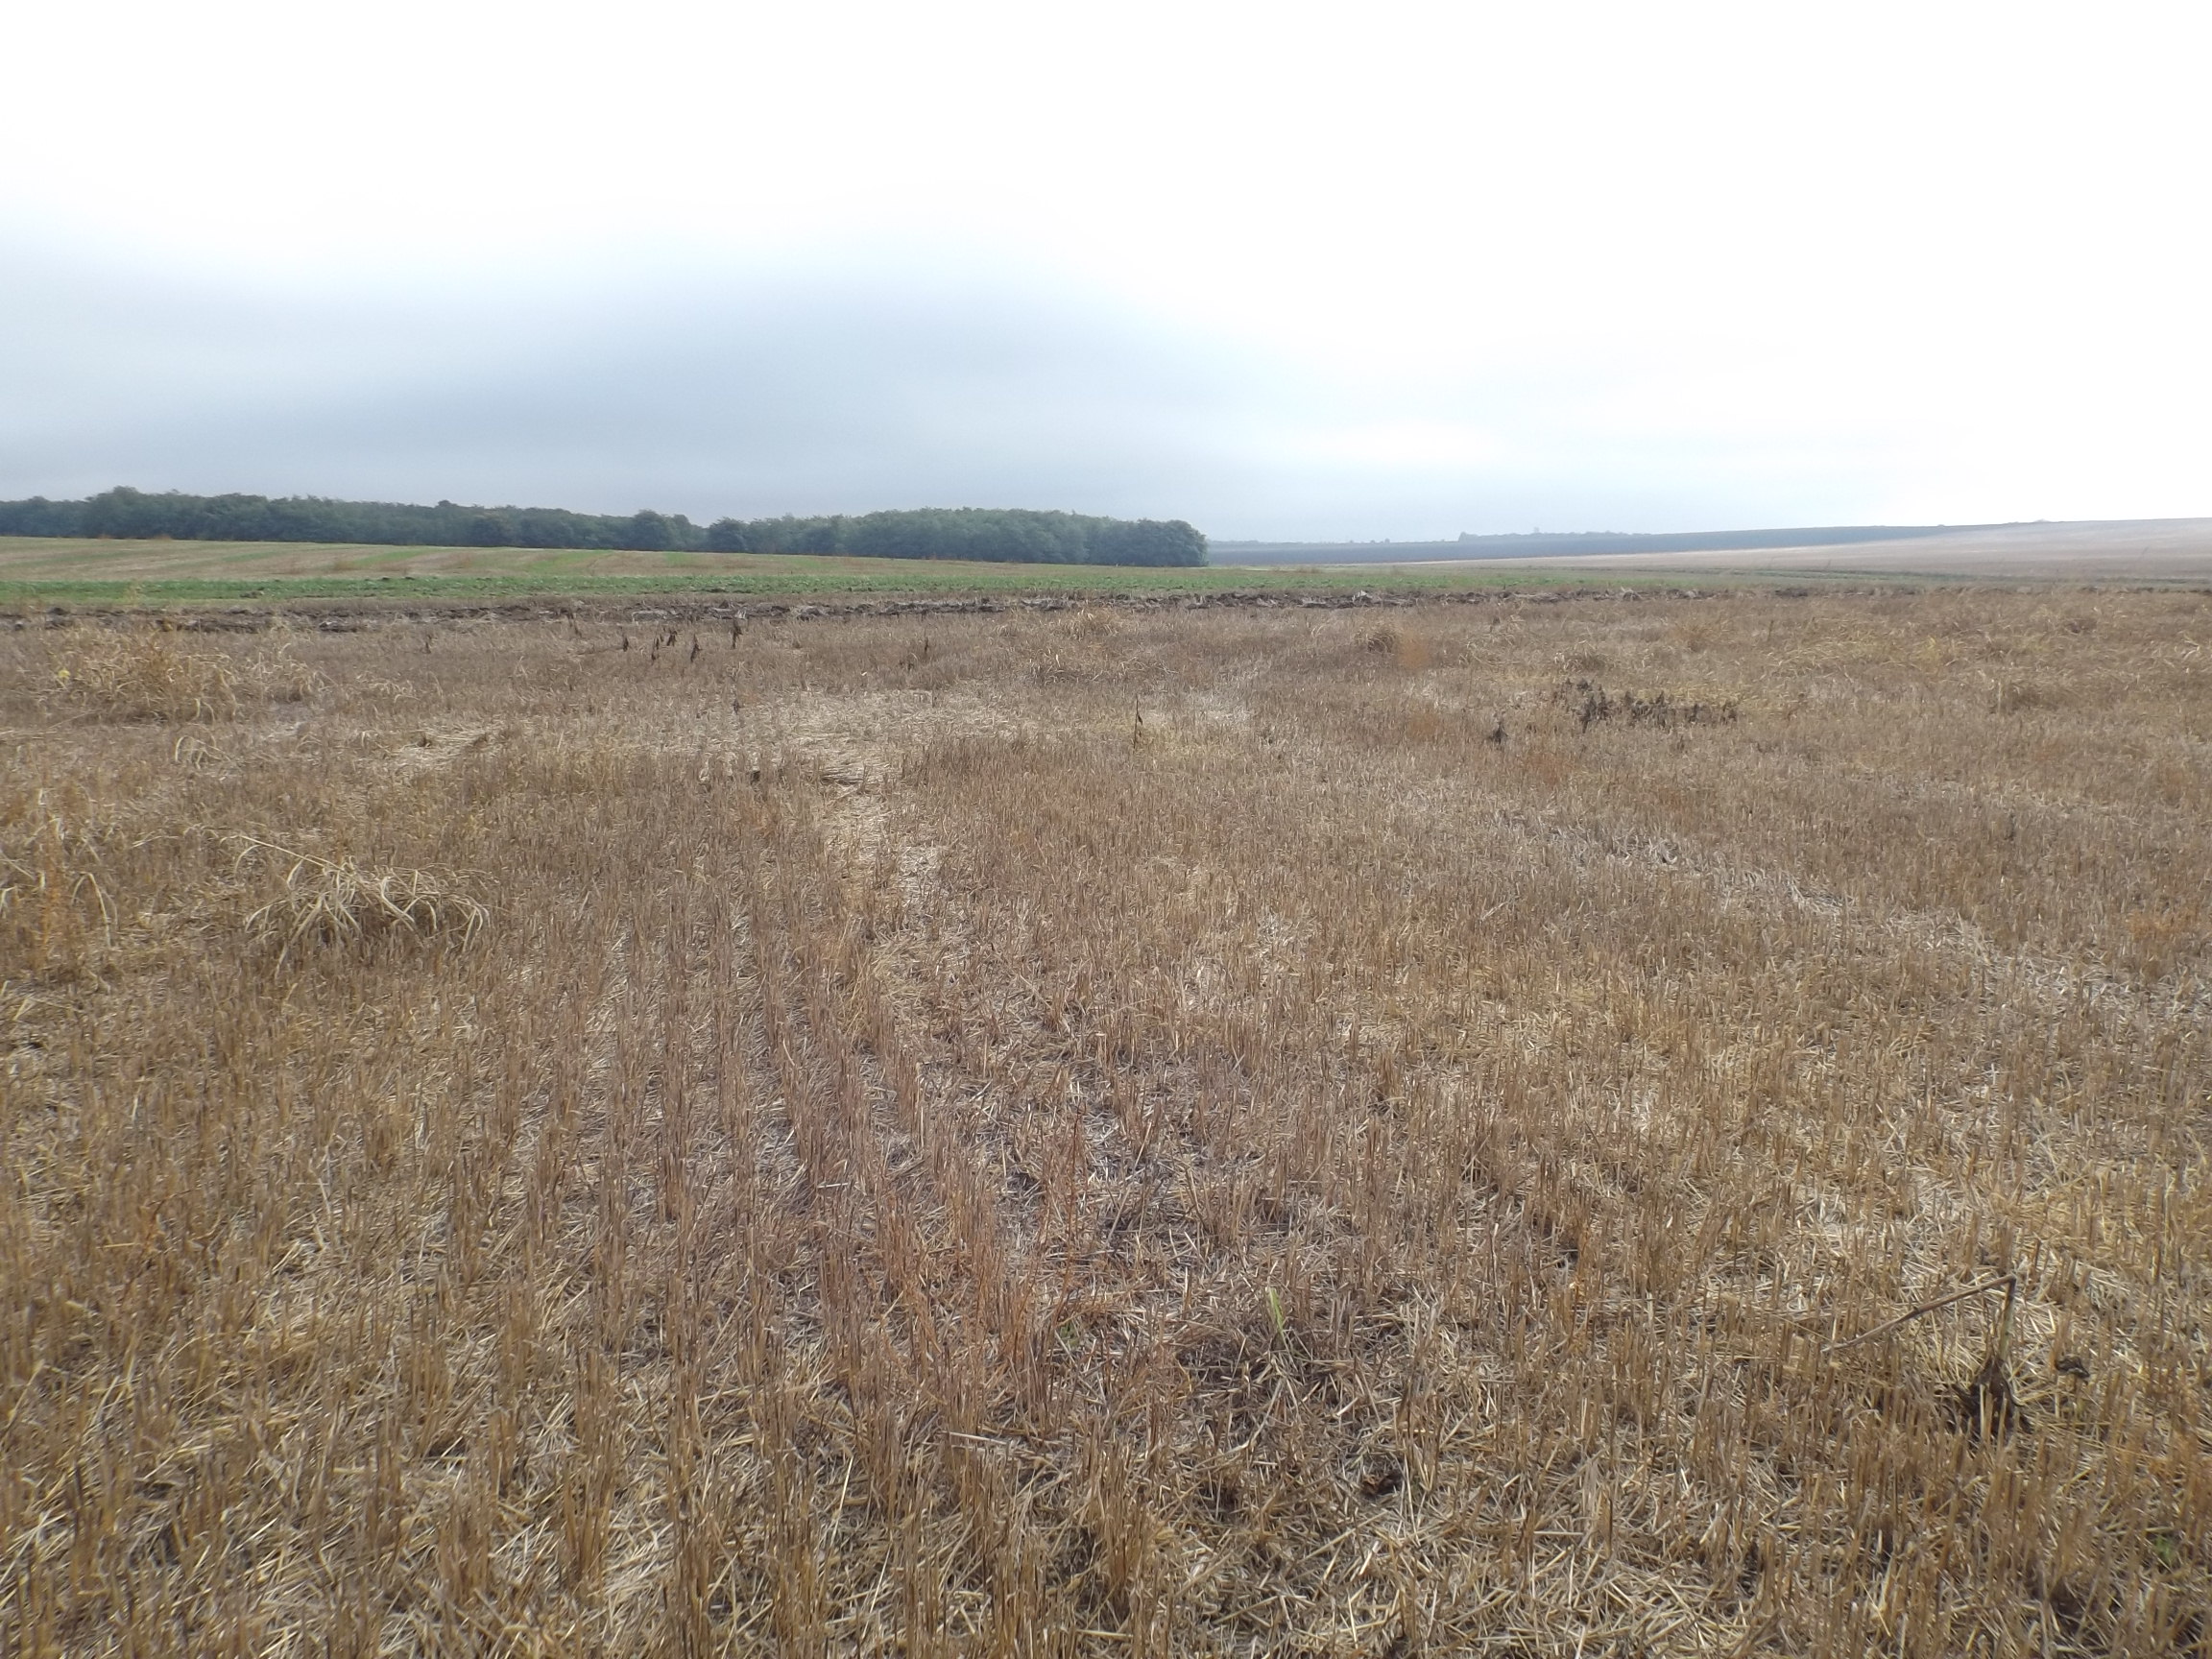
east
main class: Cropland
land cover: Oats
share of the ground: 50 - 75 %
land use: Agriculture (excluding fallow land and kitchen gardens)
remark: Harvested field
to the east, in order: Oats; Grass margins; Tracks; Grass margins; Common wheat
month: September
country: BG
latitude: 43.9762
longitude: 26.3749
